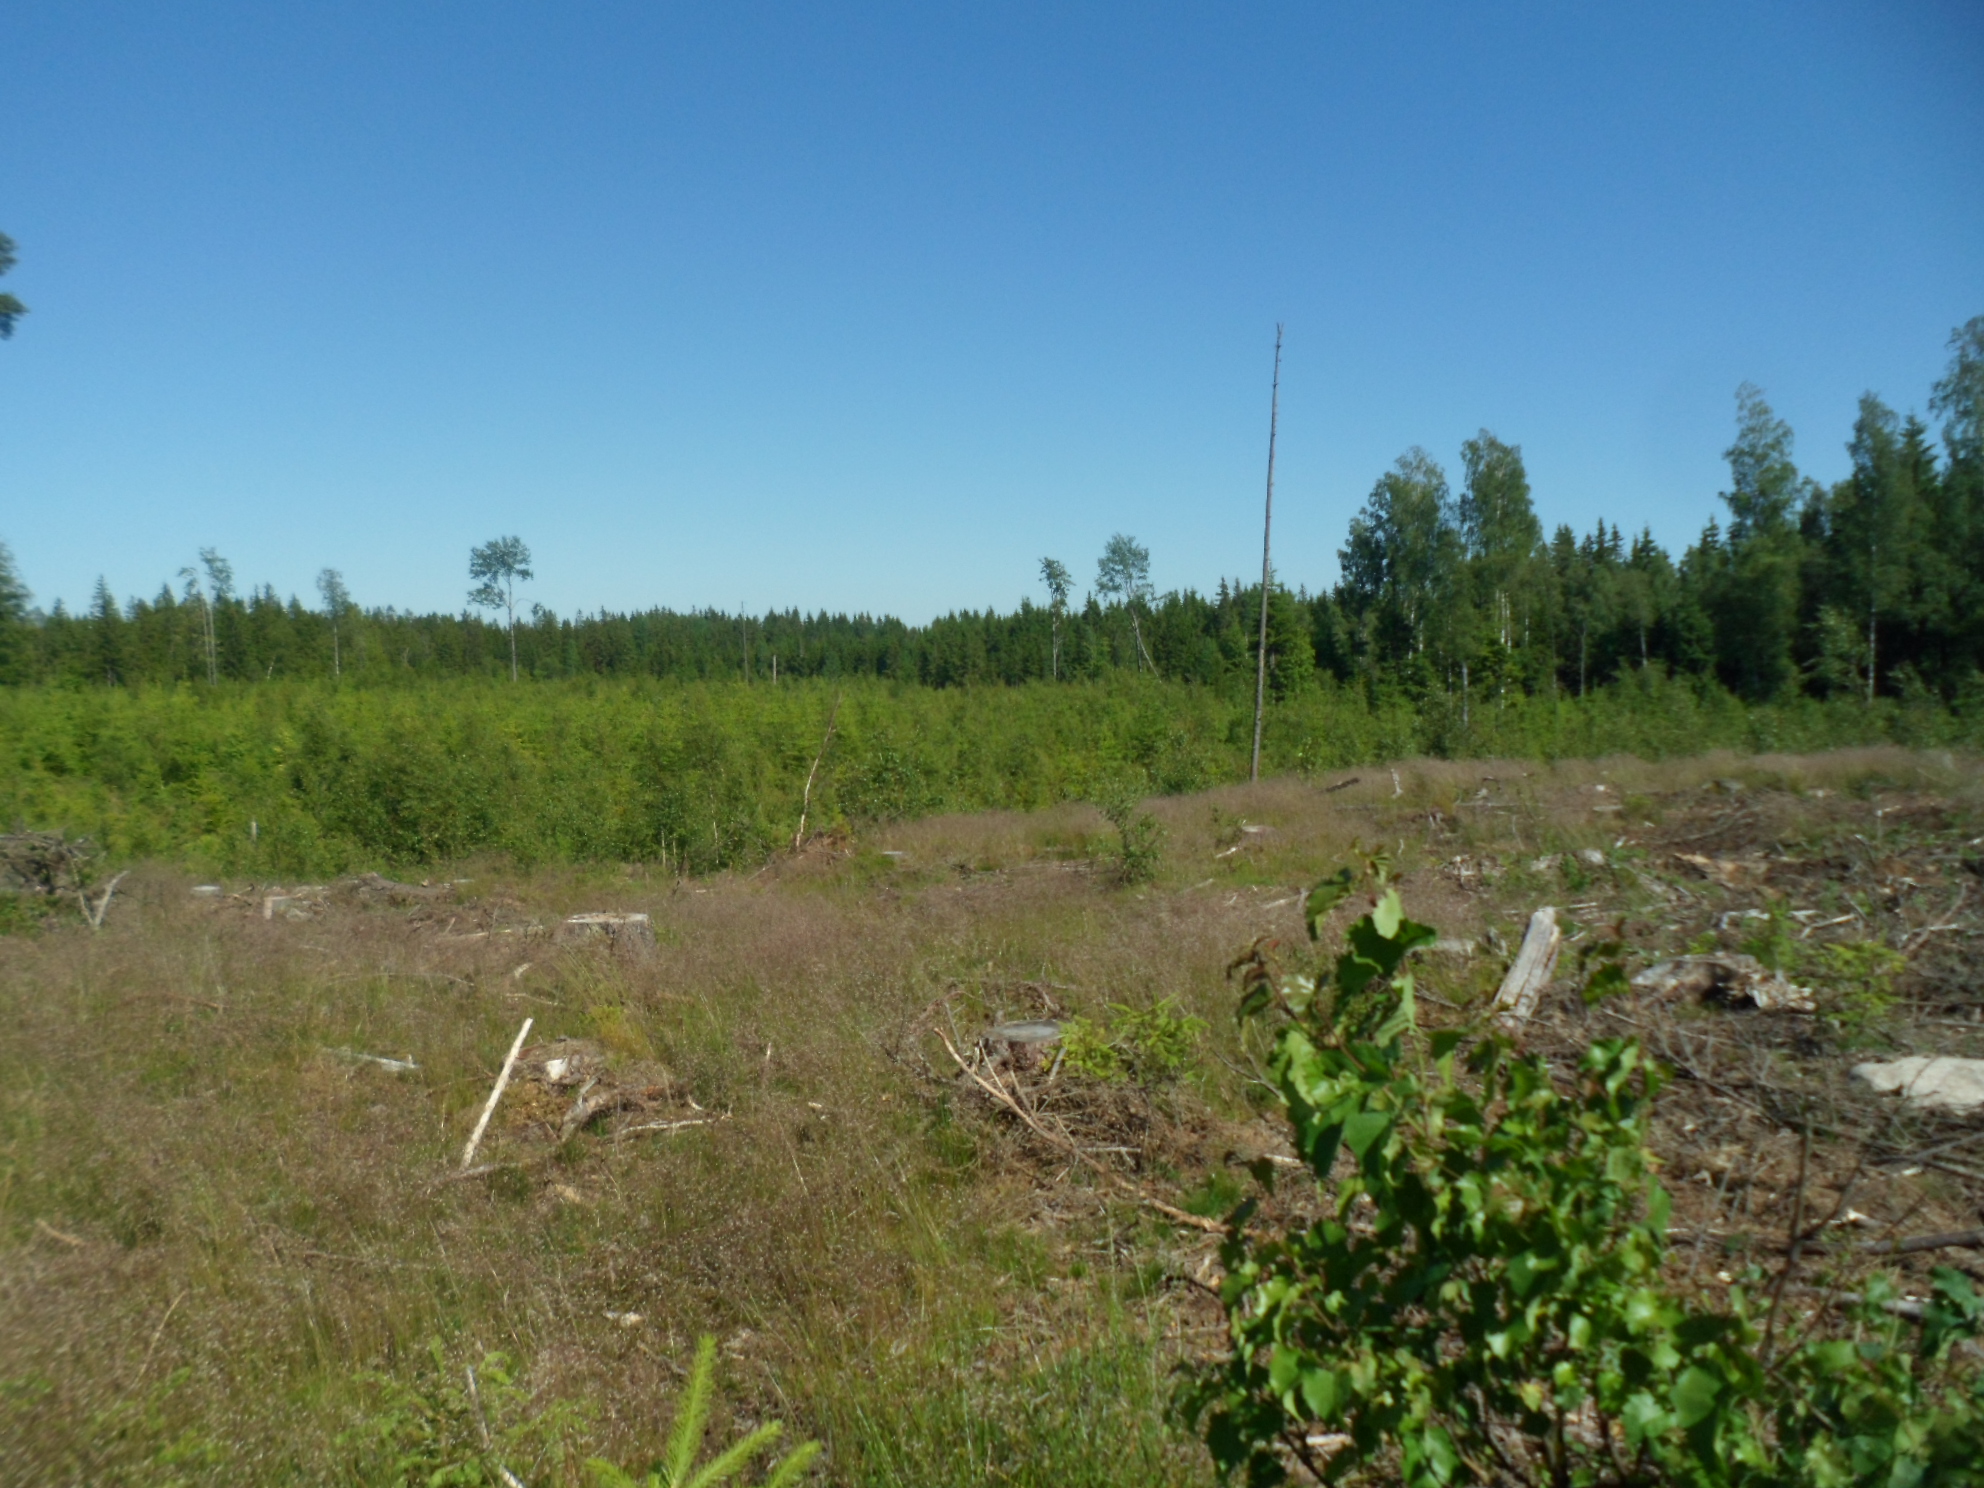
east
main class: Woodland
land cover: Spruce dominated mixed woodland
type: boreal forest
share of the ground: 10 - 25 %
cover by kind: herbaceous plants 40 %, shrubs 20 %, broadleaved forest trees 15 %, coniferous forest trees 10 %, lichens and mosses 10 %, unconsolidated bare surface 5 %
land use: Forestry
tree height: < 5 m
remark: Clear cut
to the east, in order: Spruce dominated mixed woodland; Grassland with sparse tree/shrub cover; Spruce dominated mixed woodland; Broadleaved woodland
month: July
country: SE
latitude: 57.1352
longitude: 14.5071
